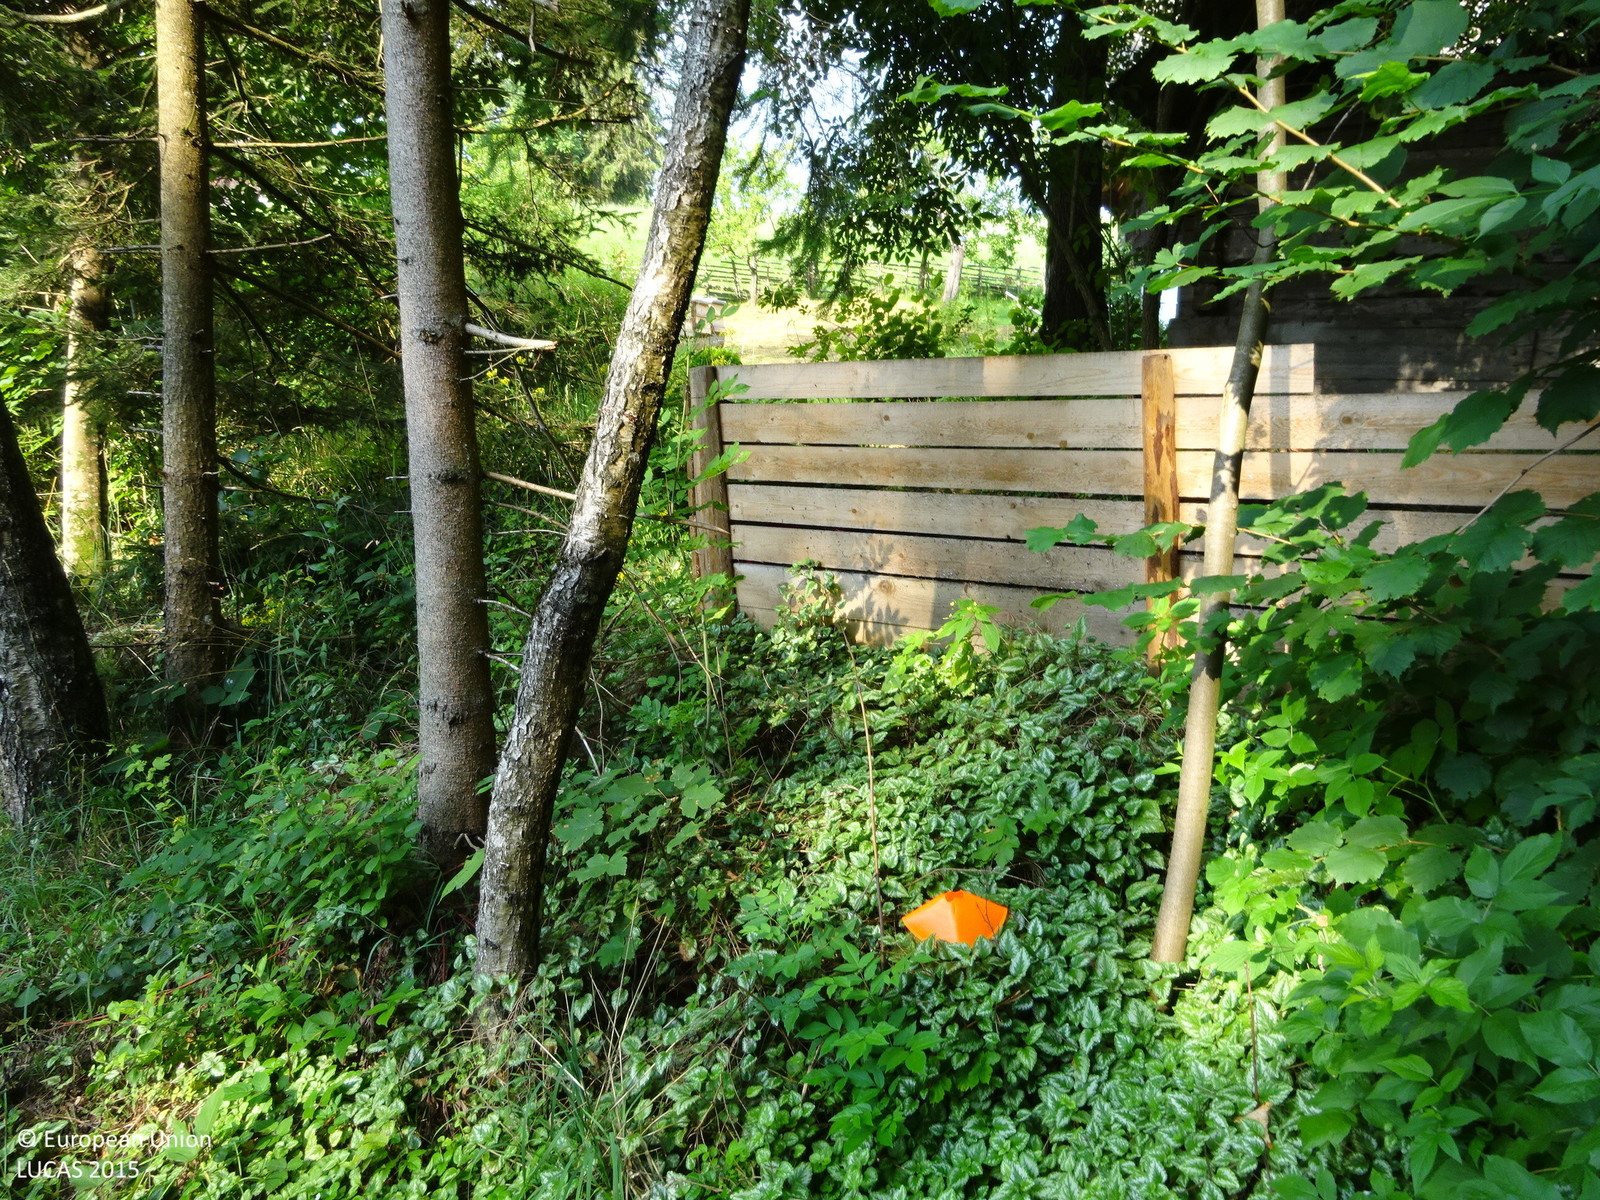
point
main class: Woodland
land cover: Spruce dominated mixed woodland
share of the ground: 10 - 25 %
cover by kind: coniferous forest trees 65 %, broadleaved forest trees 30 %, herbaceous plants 5 %
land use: Forestry
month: August
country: AT
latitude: 47.3734
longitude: 15.6825
